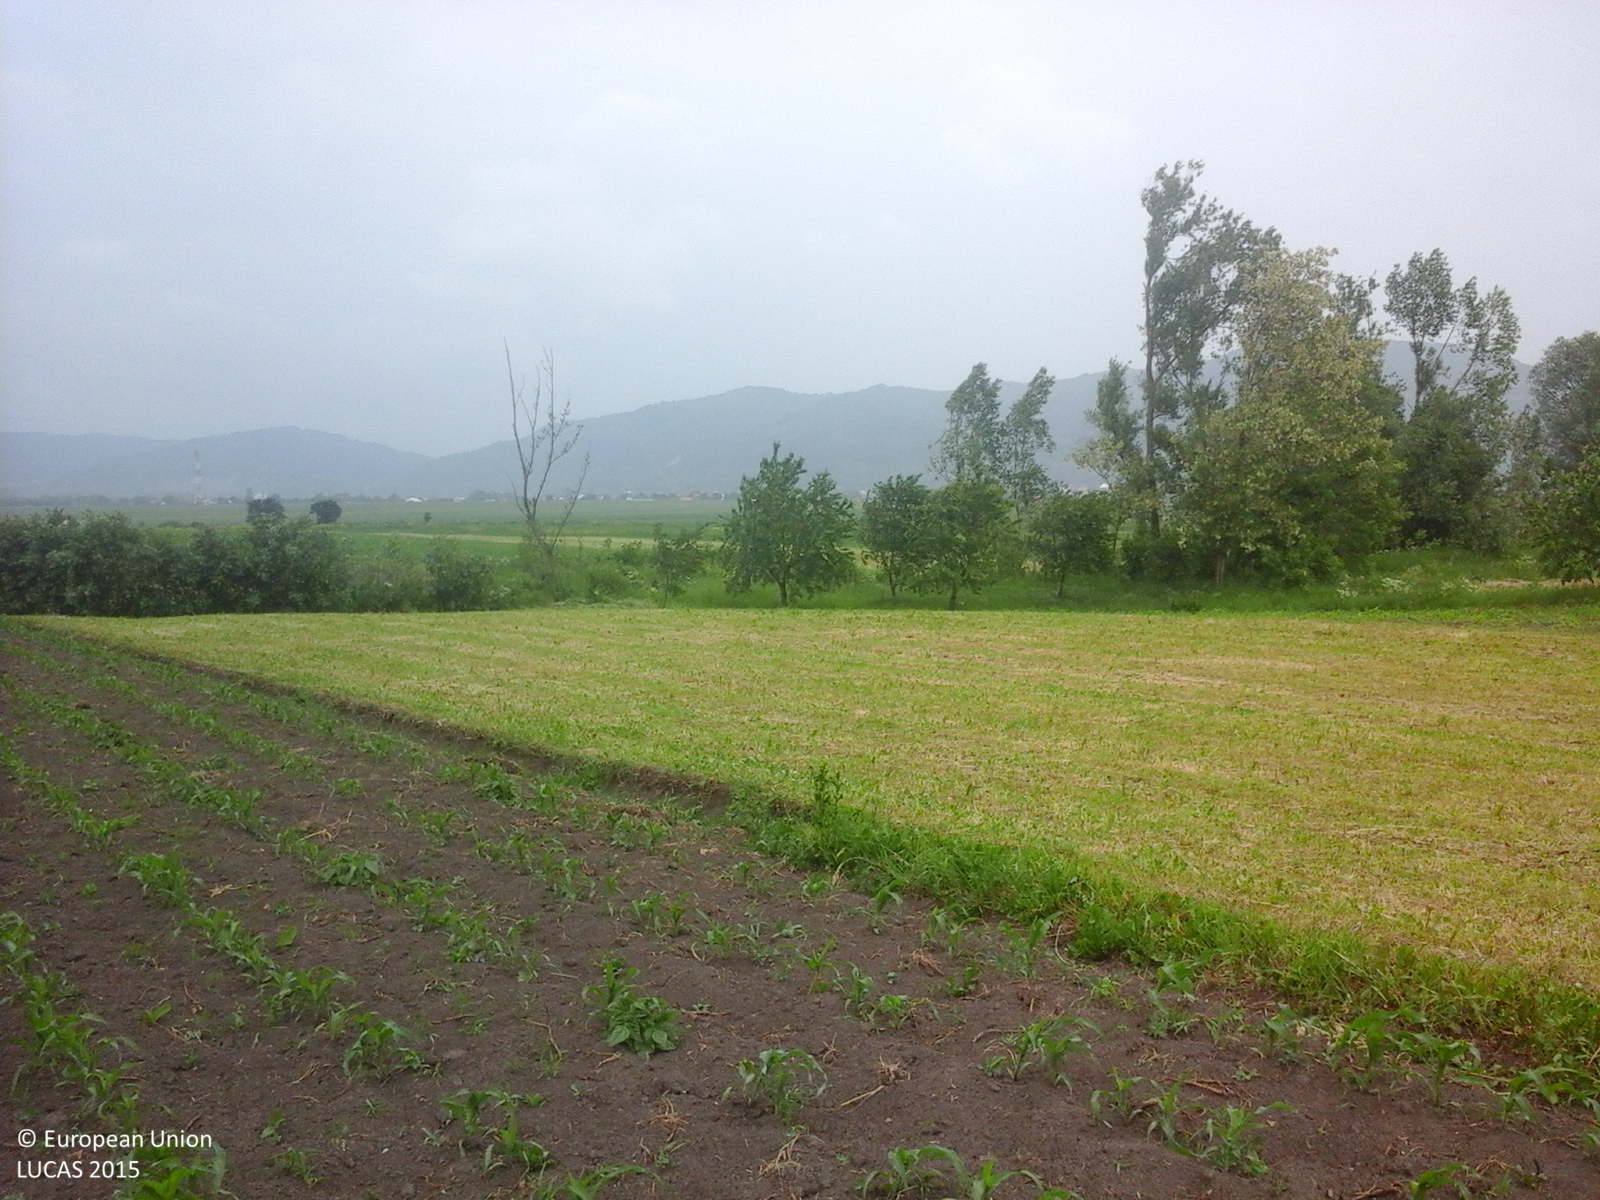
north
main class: Cropland
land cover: Maize
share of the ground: 10 - 25 %
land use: Agriculture (excluding fallow land and kitchen gardens)
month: June
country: RO
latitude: 47.1967
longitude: 26.3310
